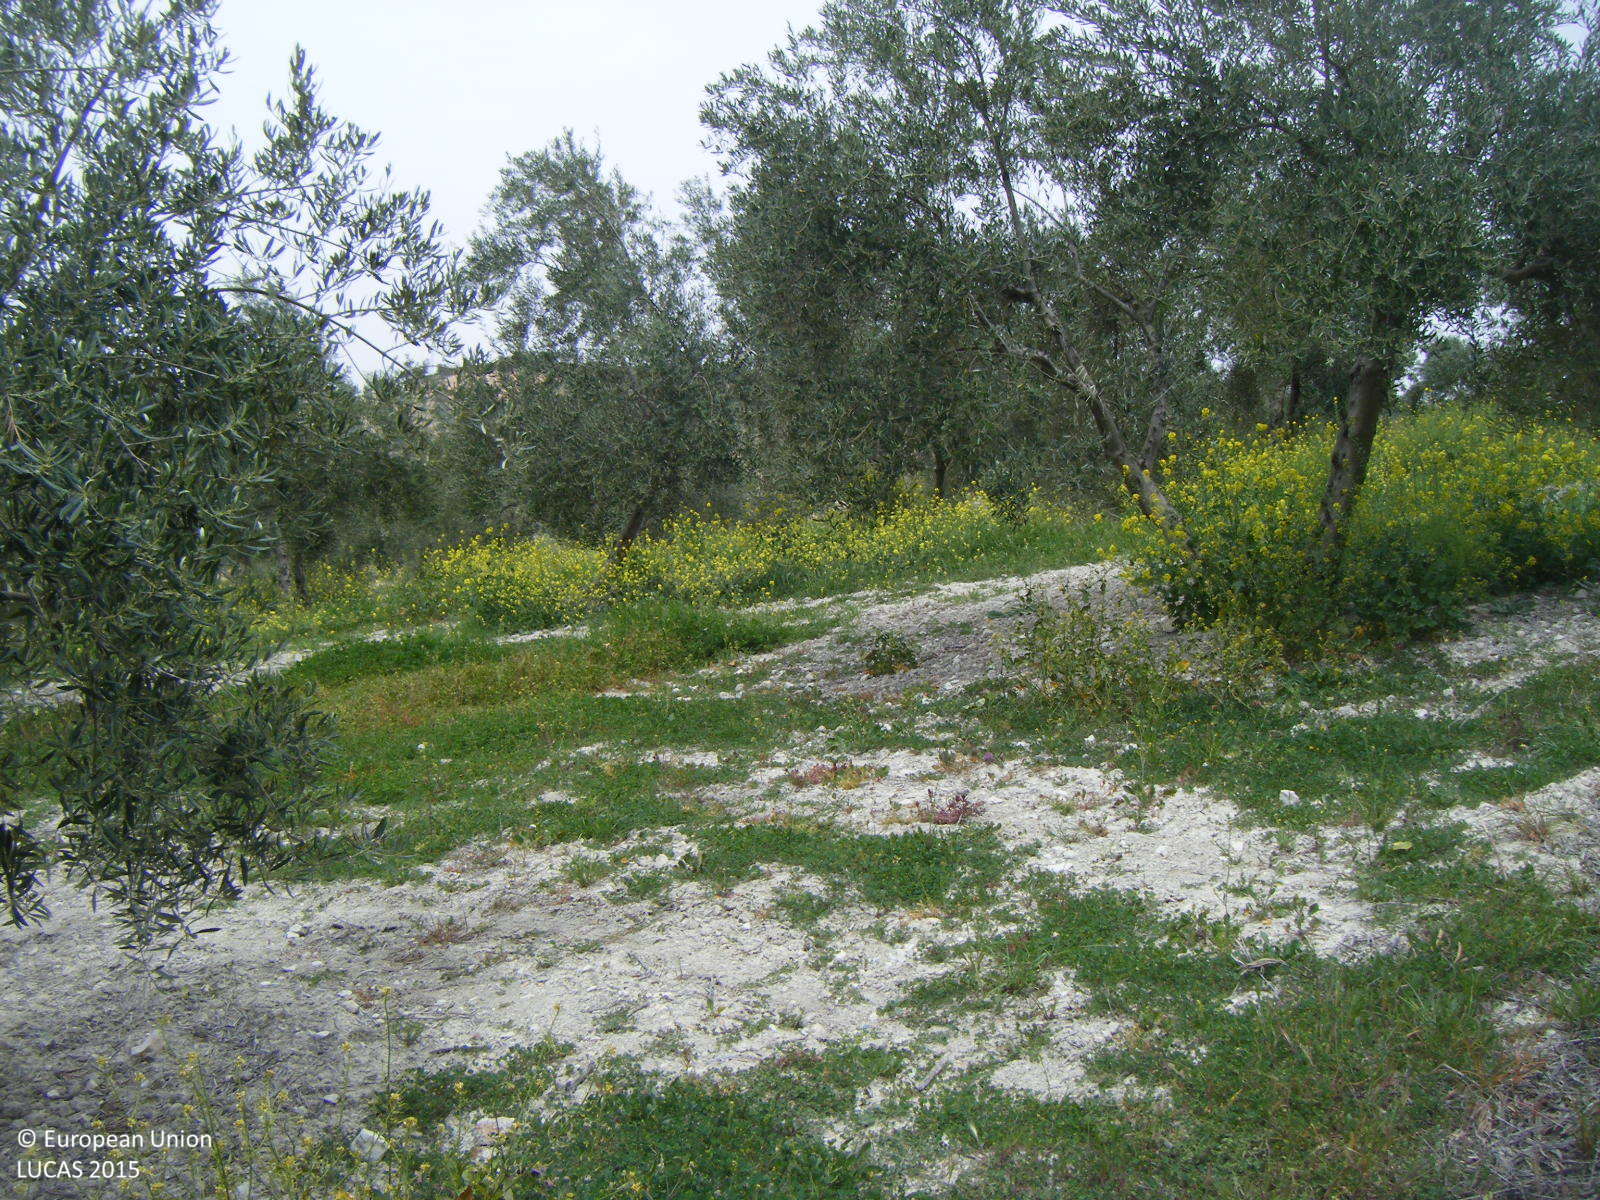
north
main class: Cropland
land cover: Olive groves
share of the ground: 10 - 25 %
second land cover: Spontaneously vegetated surfaces
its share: > 75 %
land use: Agriculture (excluding fallow land and kitchen gardens)
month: April
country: ES
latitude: 37.1293
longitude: -4.1201
